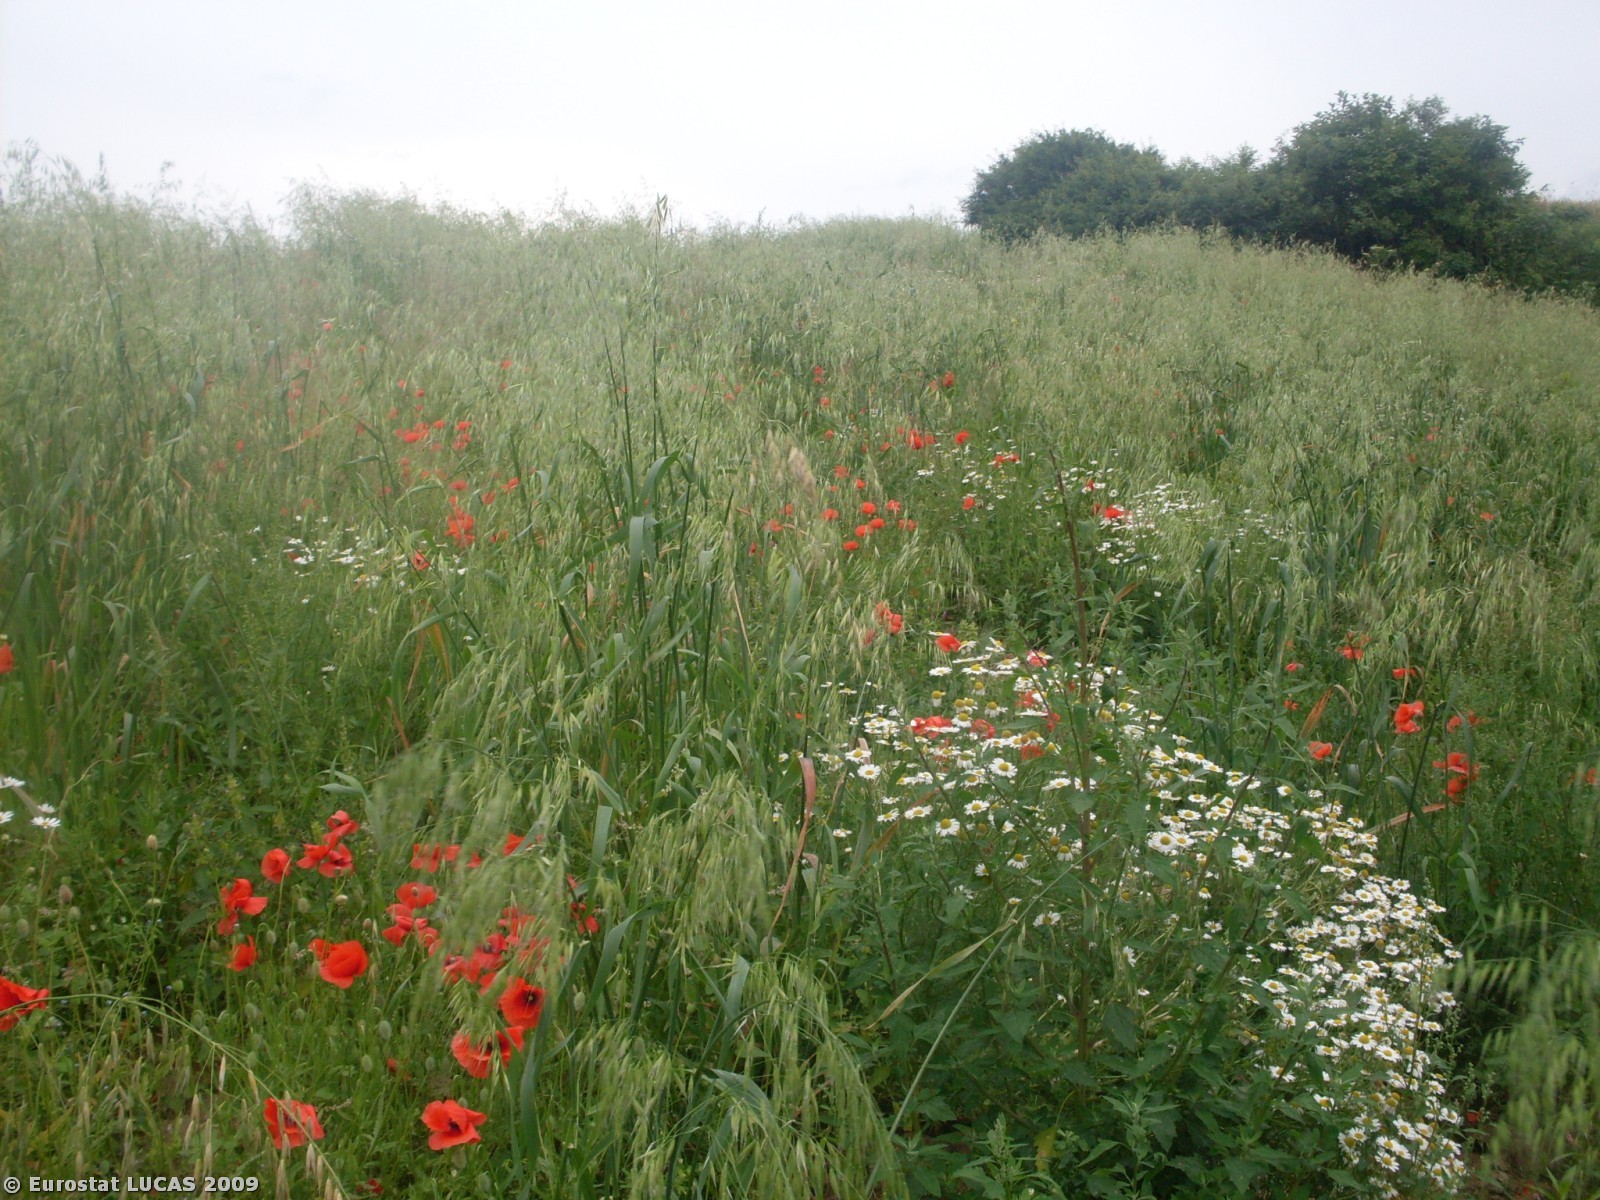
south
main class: Grassland
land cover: Spontaneously vegetated surfaces
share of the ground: > 75 %
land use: Unused
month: July
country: PL
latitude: 50.1825
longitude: 20.5557
